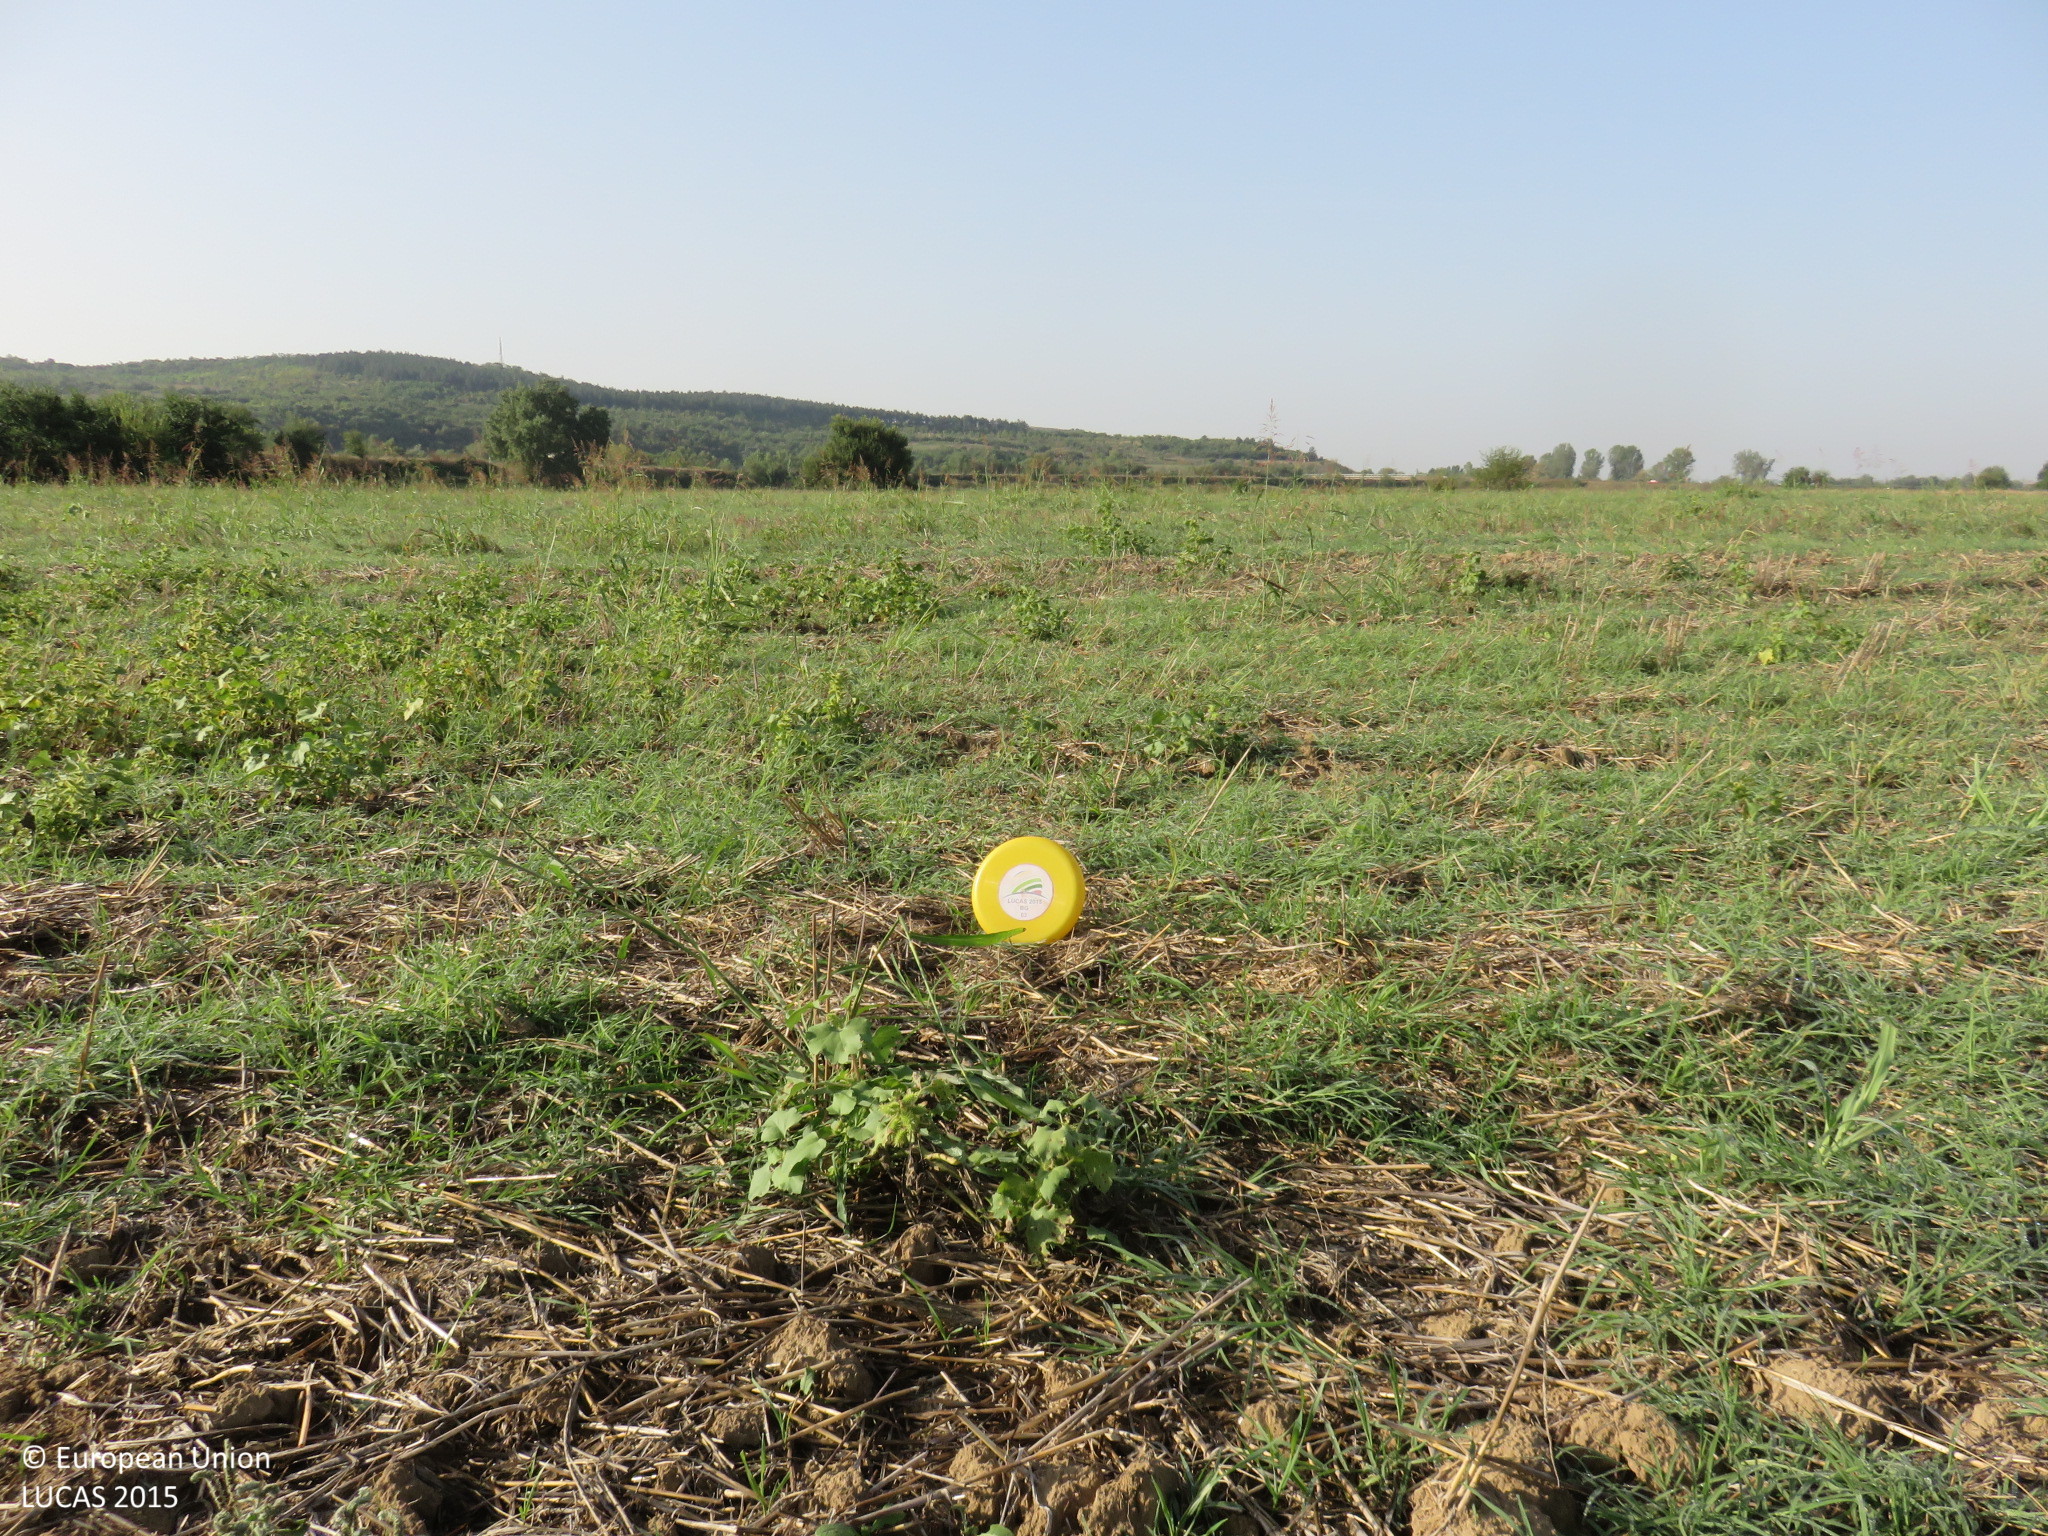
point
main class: Cropland
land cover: Common wheat
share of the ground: < 10 %
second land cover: Spontaneously vegetated surfaces
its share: 50 - 75 %
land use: Agriculture (excluding fallow land and kitchen gardens)
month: September
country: BG
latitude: 43.4988
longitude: 24.5697
